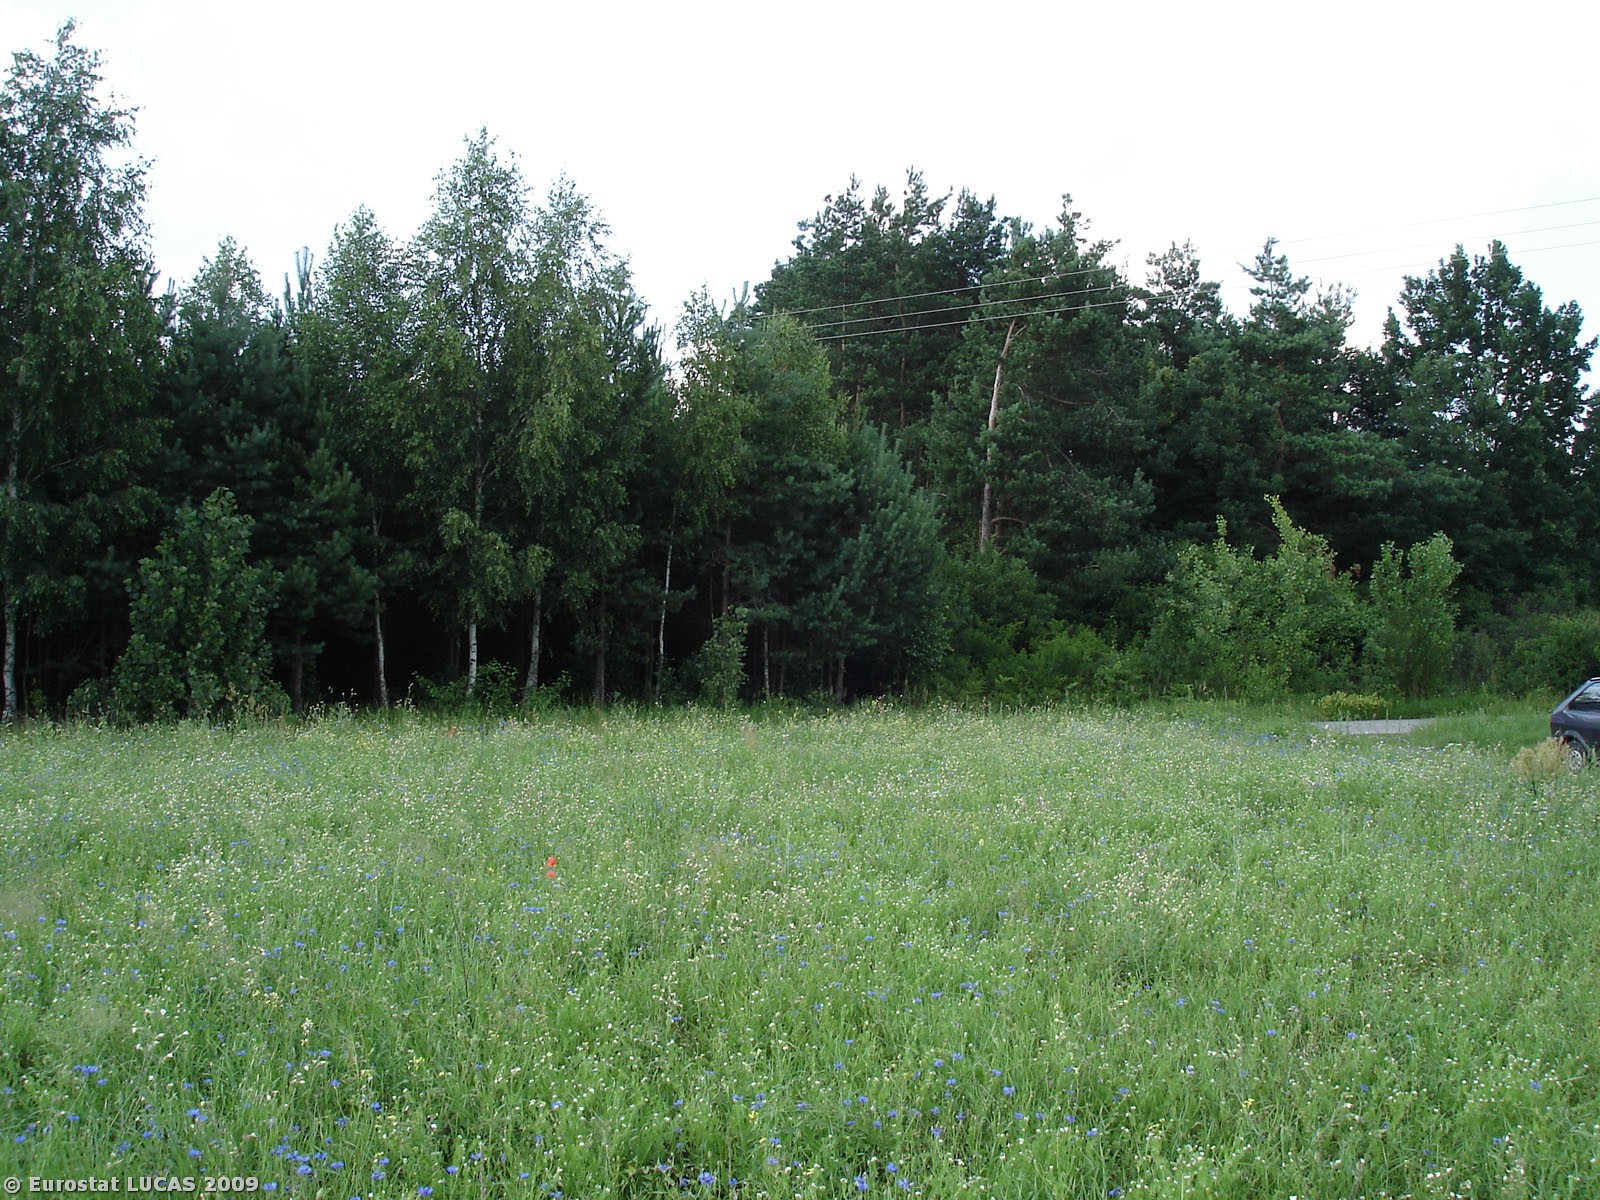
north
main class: Cropland
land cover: Lucerne
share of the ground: > 75 %
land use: Agriculture (excluding fallow land and kitchen gardens)
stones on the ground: < 10 %
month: March
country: PL
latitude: 51.0019
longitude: 19.9073
